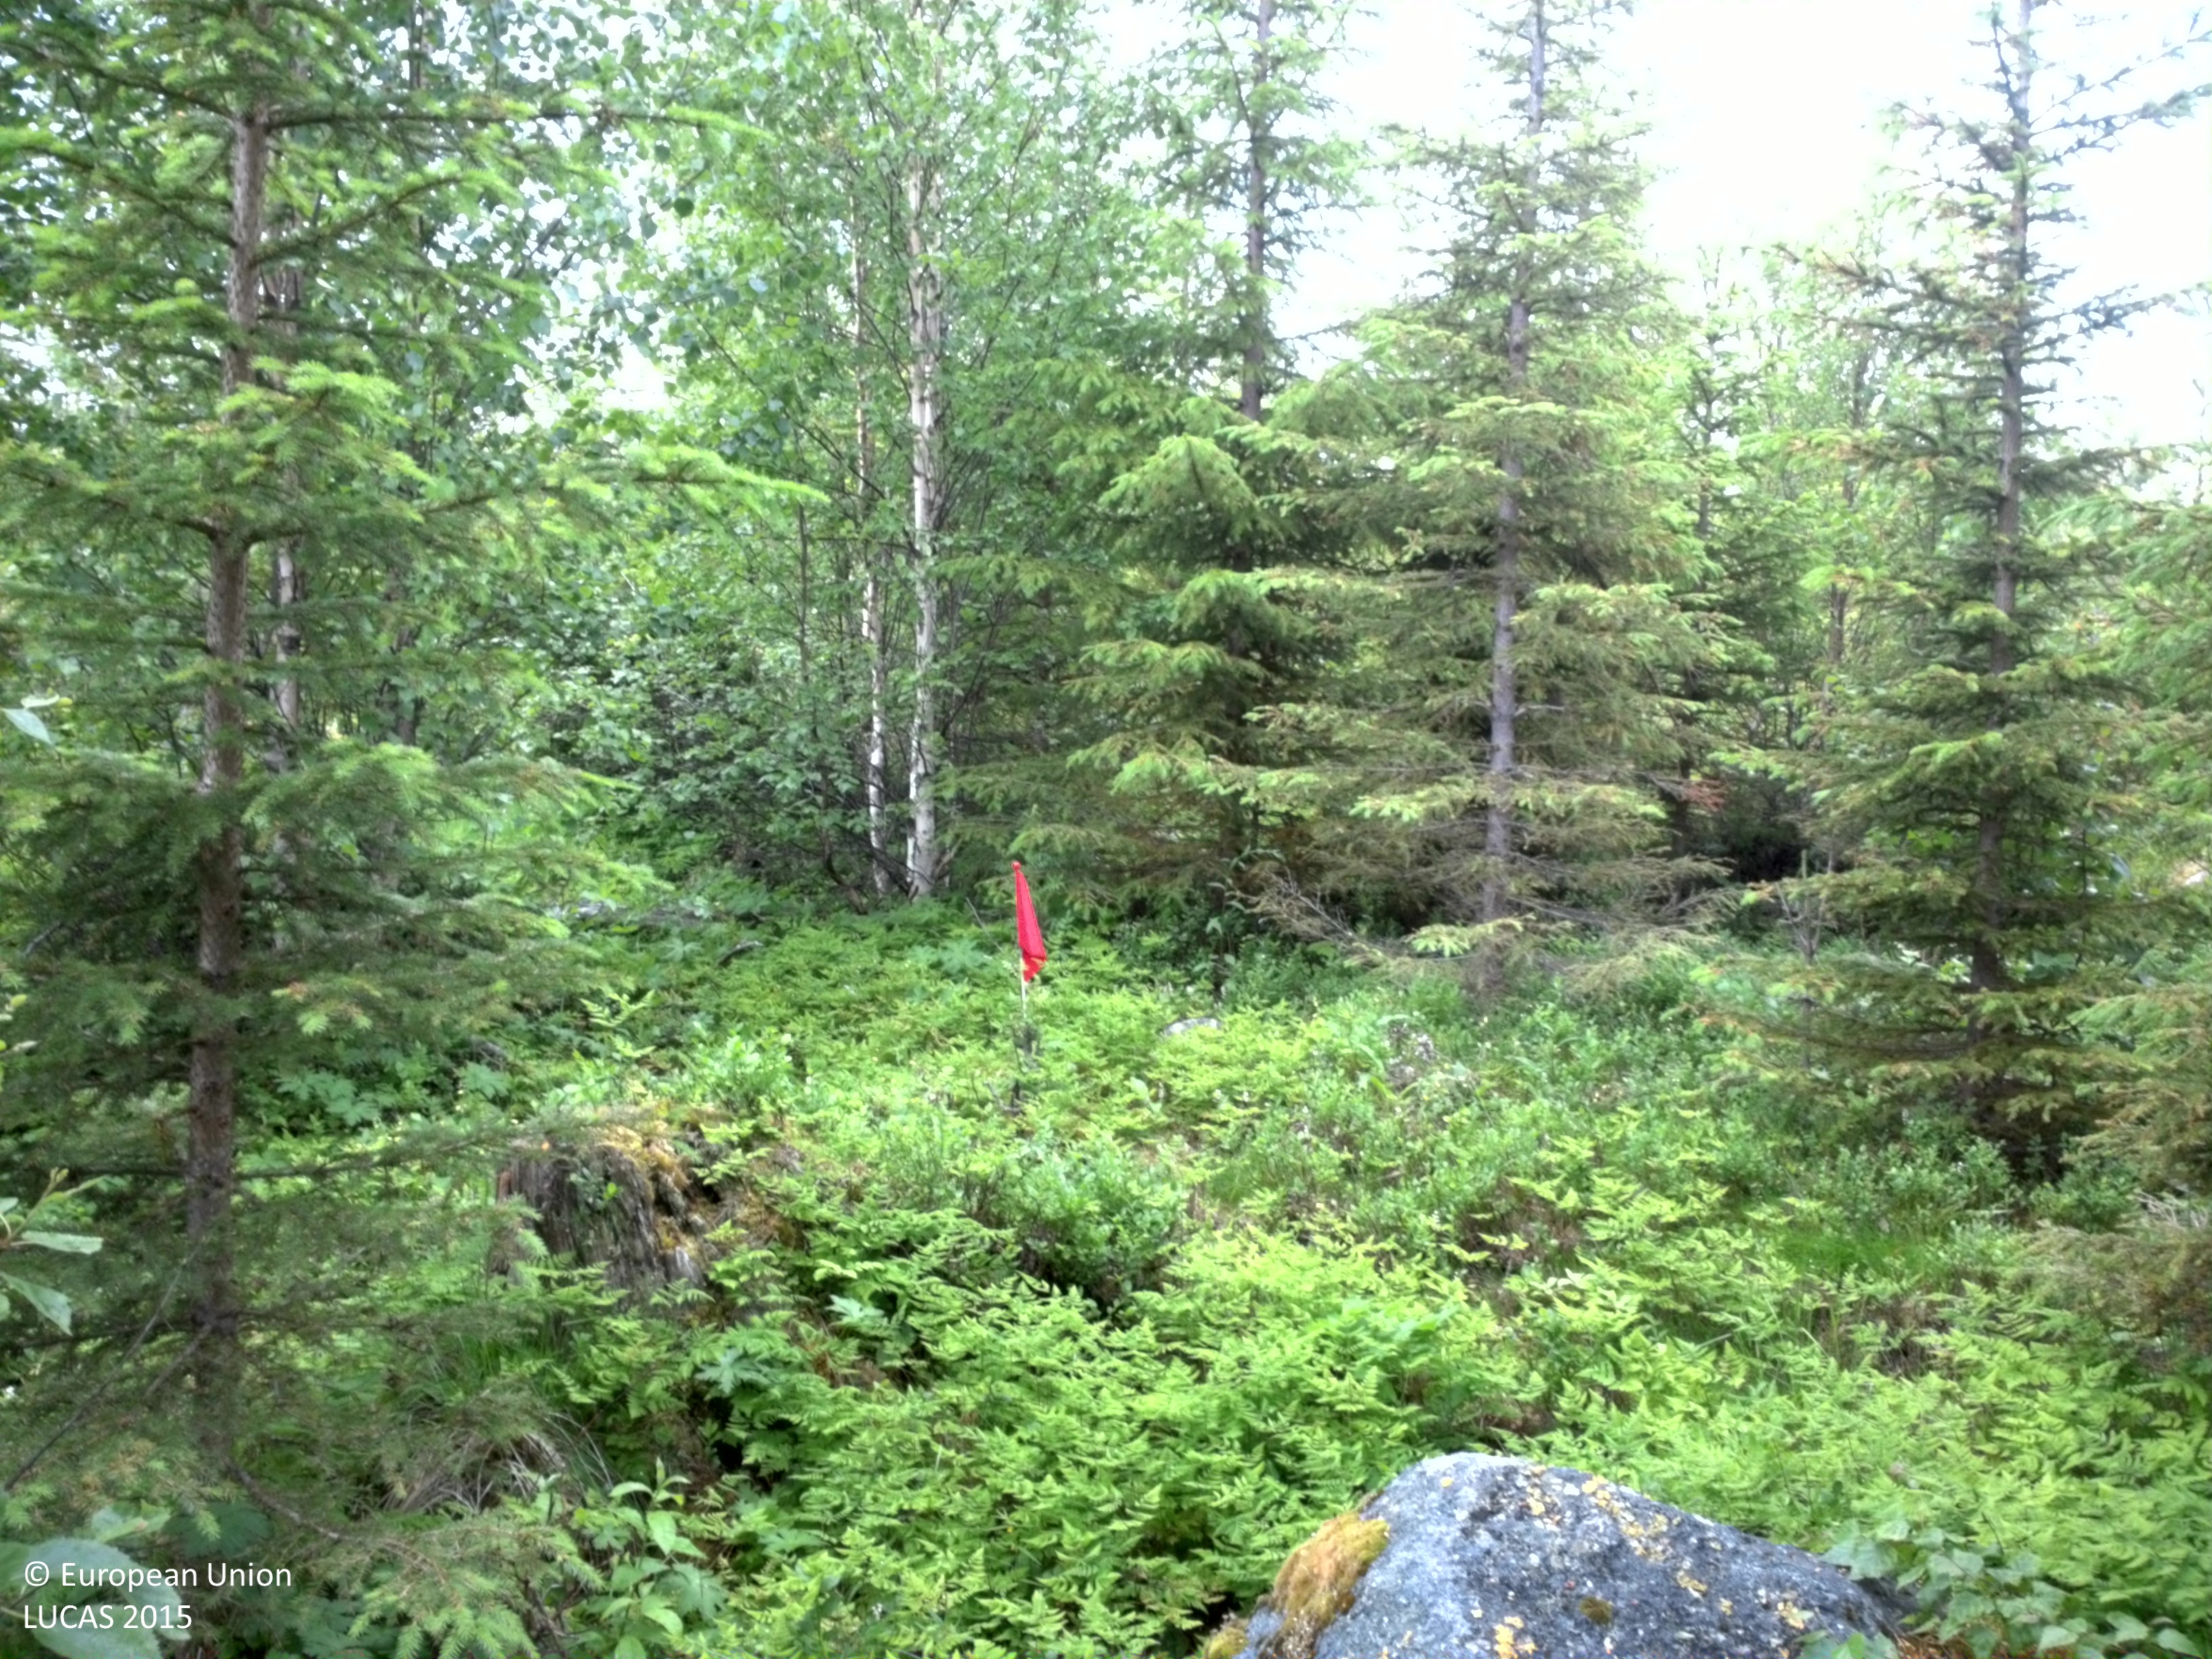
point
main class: Woodland
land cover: Spruce dominated mixed woodland
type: boreal forest
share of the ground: 50 - 75 %
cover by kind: coniferous forest trees 45 %, shrubs 20 %, herbaceous plants 20 %, broadleaved forest trees 15 %
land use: Forestry
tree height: > 5 m
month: July
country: SE
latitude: 64.7152
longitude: 18.5070
